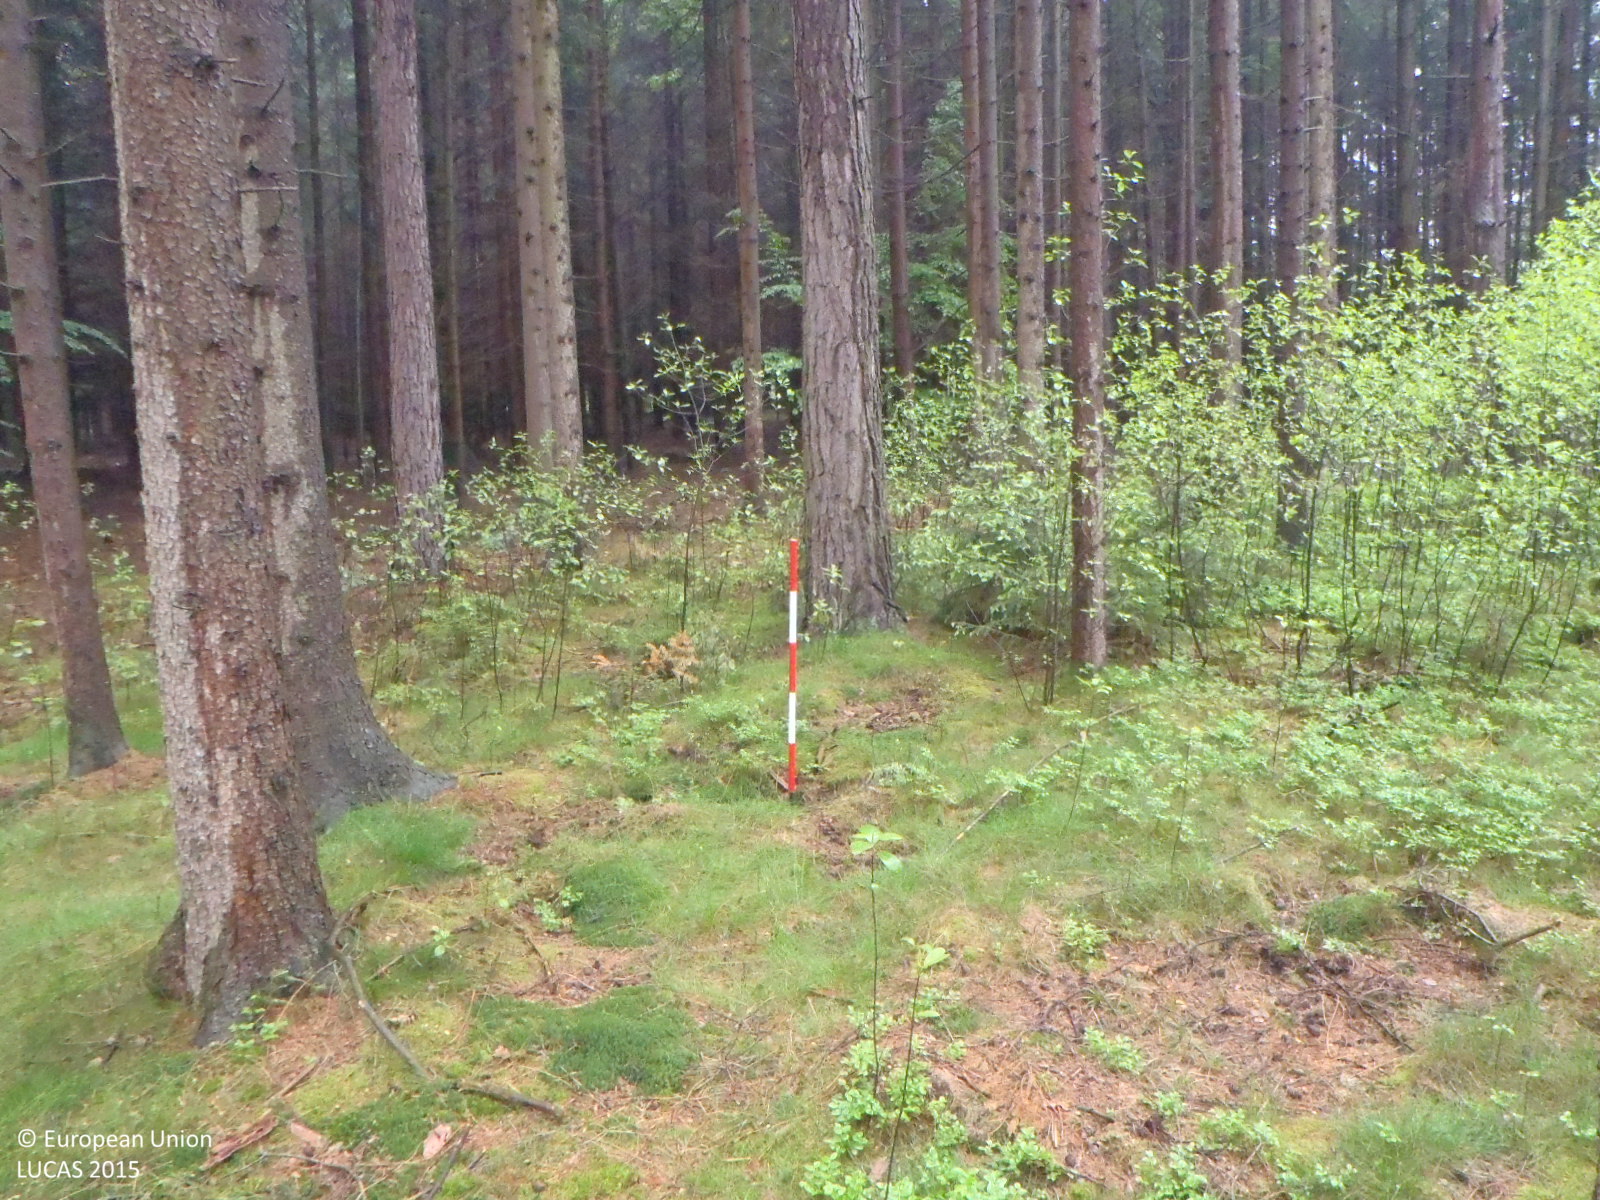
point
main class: Woodland
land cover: Other coniferous woodland
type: hemiboreal forest and nemoral coniferous forest and mixed broadleaved-coniferous forest
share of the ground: > 75 %
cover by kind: coniferous forest trees 75 %, broadleaved forest trees 10 %, shrubs 5 %, herbaceous plants 5 %, lichens and mosses 5 %
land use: Forestry
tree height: > 5 m
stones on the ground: 10 - 25 %
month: May
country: CZ
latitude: 48.7835
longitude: 14.4240
